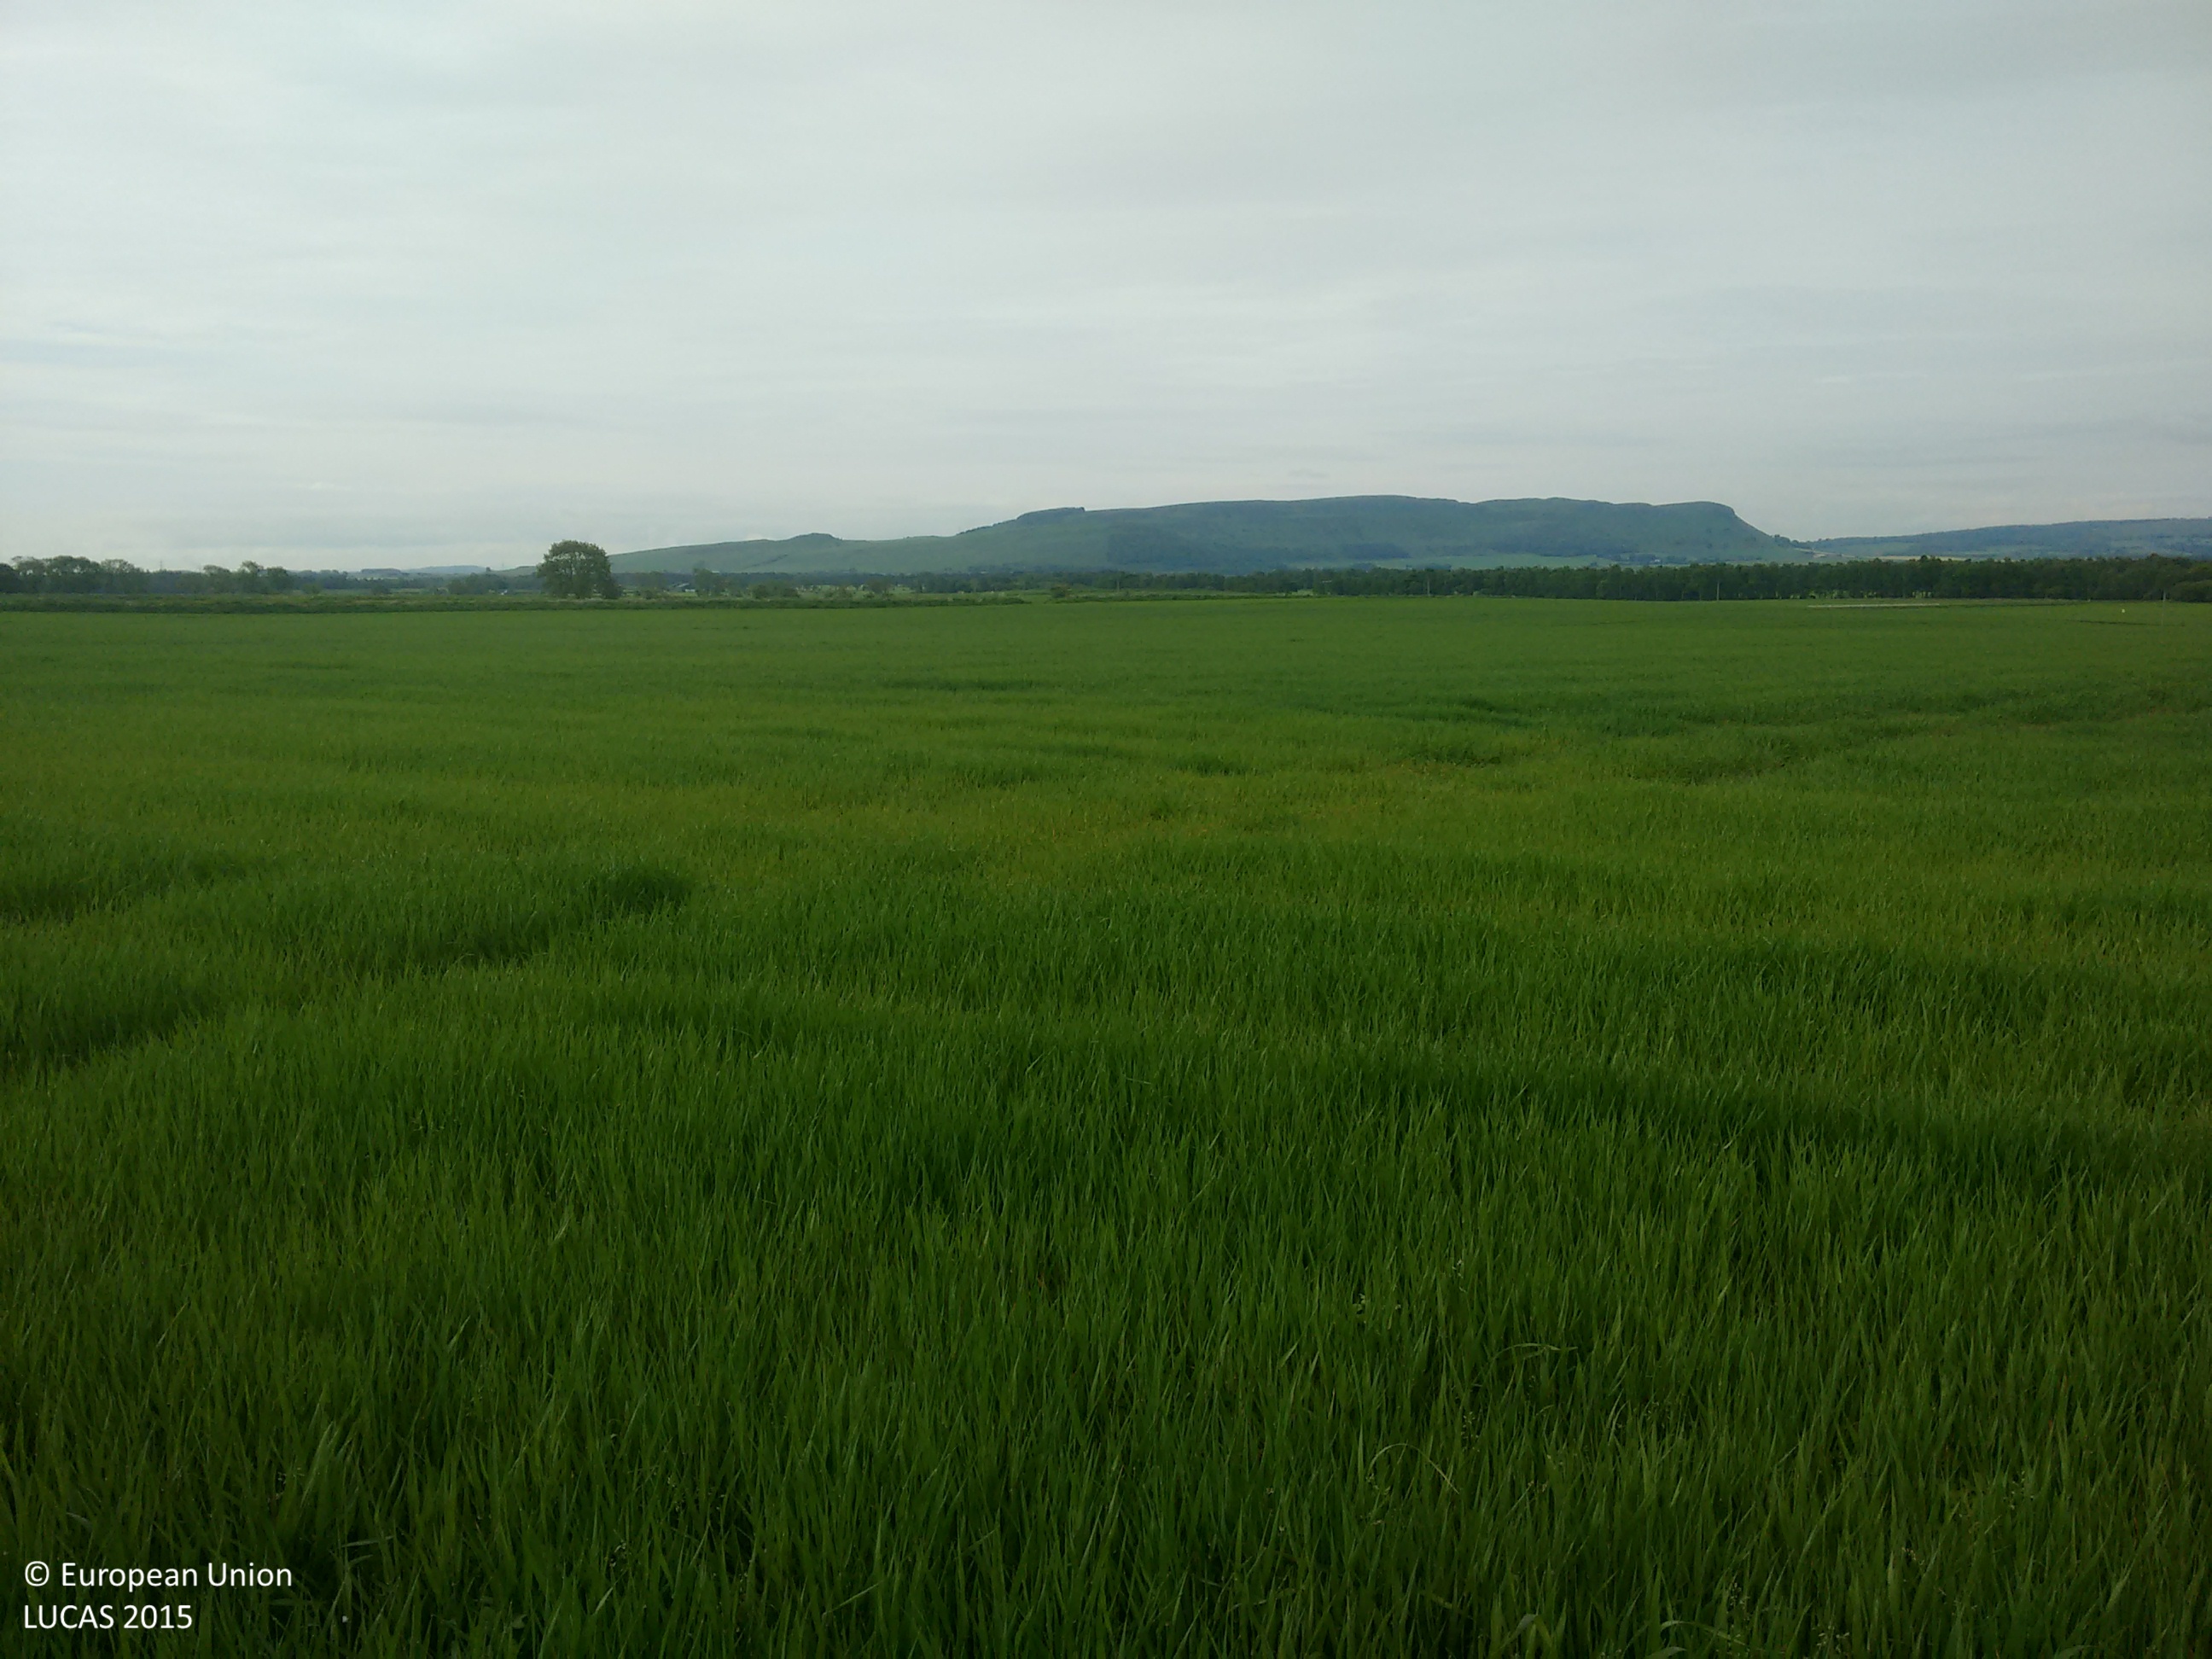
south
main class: Cropland
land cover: Barley
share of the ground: > 75 %
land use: Agriculture (excluding fallow land and kitchen gardens)
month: June
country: GB
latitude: 56.2168
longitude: -3.3444
